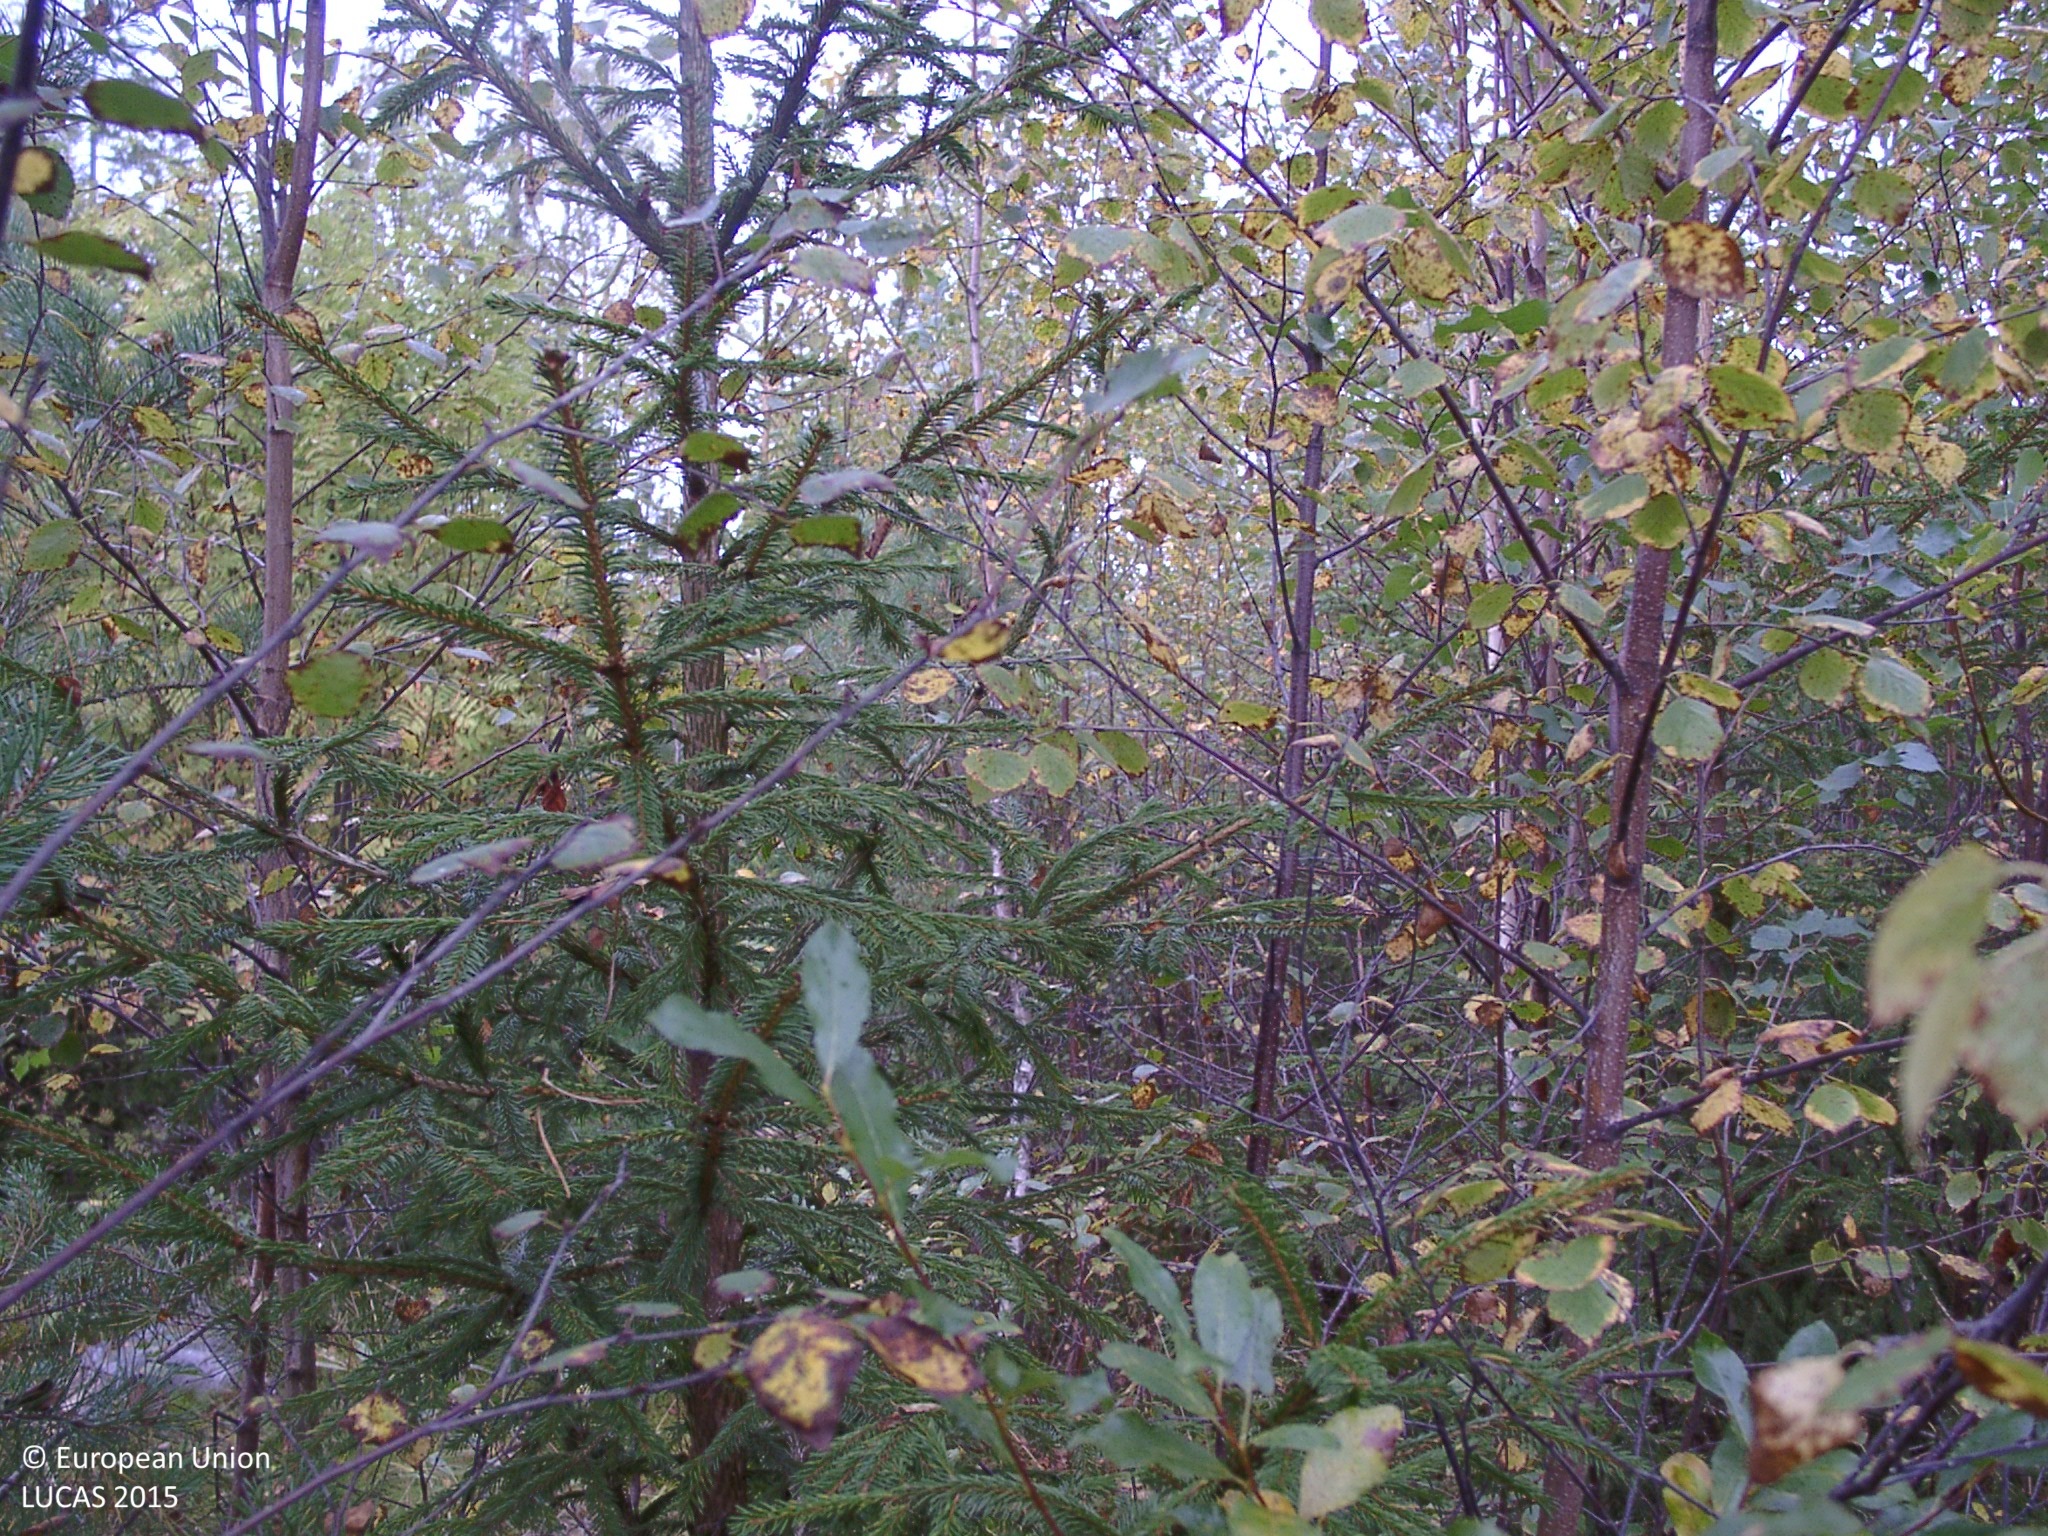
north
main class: Woodland
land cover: Broadleaved woodland
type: boreal forest
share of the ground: 50 - 75 %
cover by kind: broadleaved forest trees 60 %, lichens and mosses 20 %, coniferous forest trees 5 %, shrubs 5 %, herbaceous plants 5 %
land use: Forestry
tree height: < 5 m
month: September
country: FI
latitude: 62.8784
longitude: 25.2618
